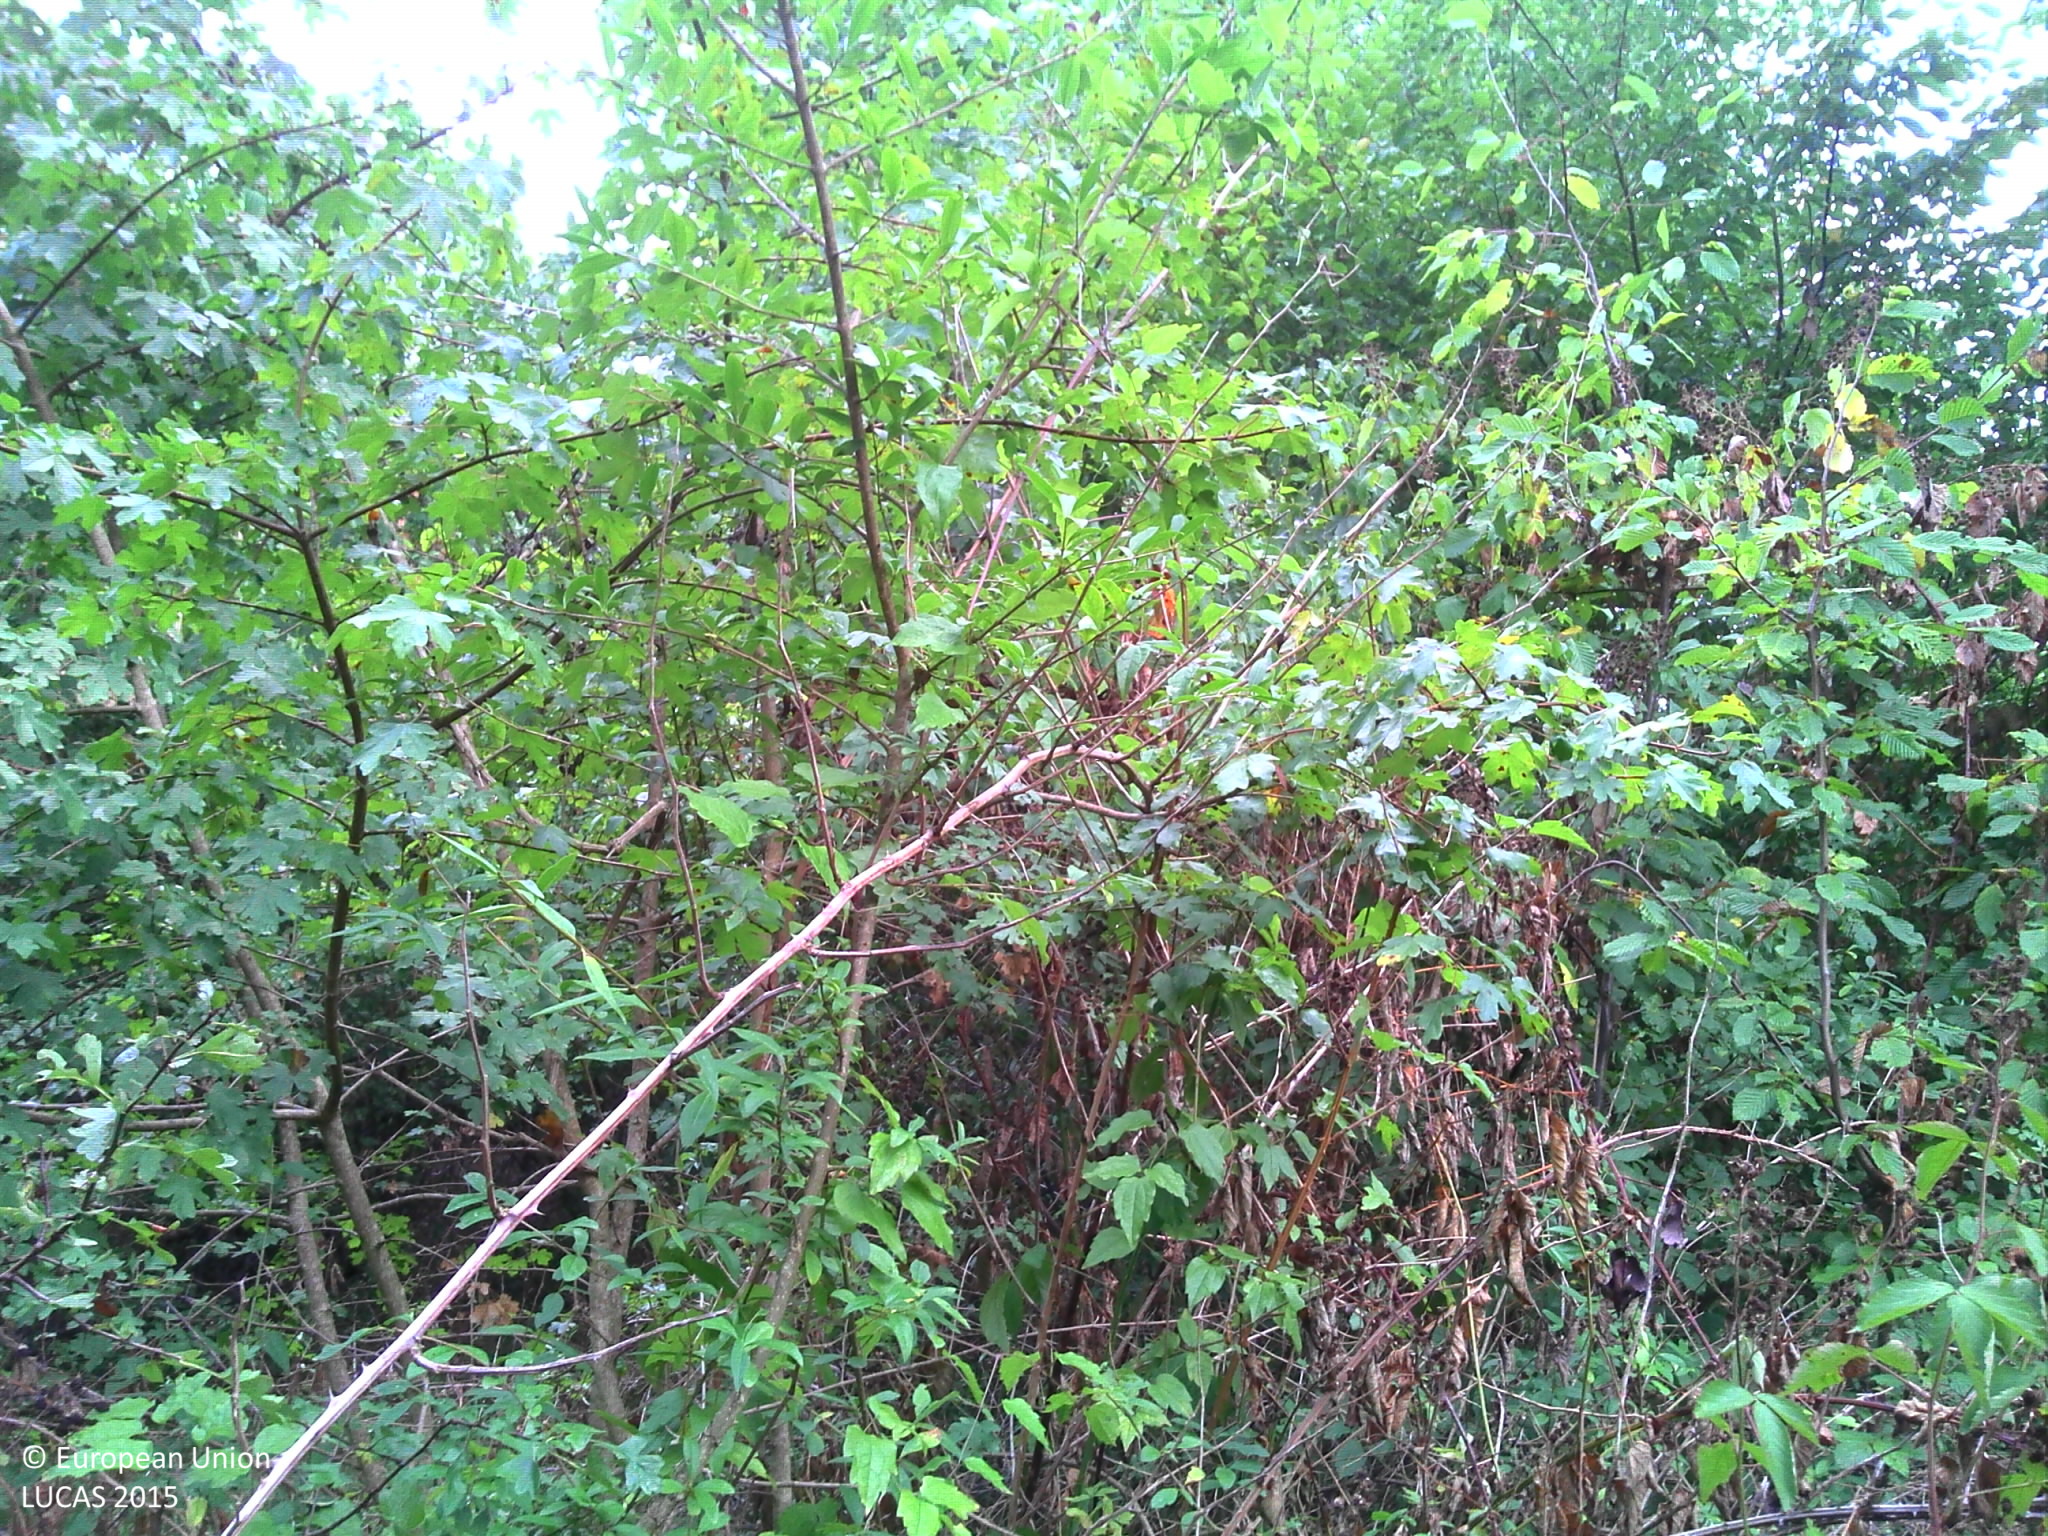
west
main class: Woodland
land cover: Broadleaved woodland
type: mesophytic deciduous forest
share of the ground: > 75 %
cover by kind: broadleaved forest trees 85 %, herbaceous plants 15 %
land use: Semi-natural and natural areas not in use
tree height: > 5 m
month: August
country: FR
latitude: 48.0504
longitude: 7.4656
